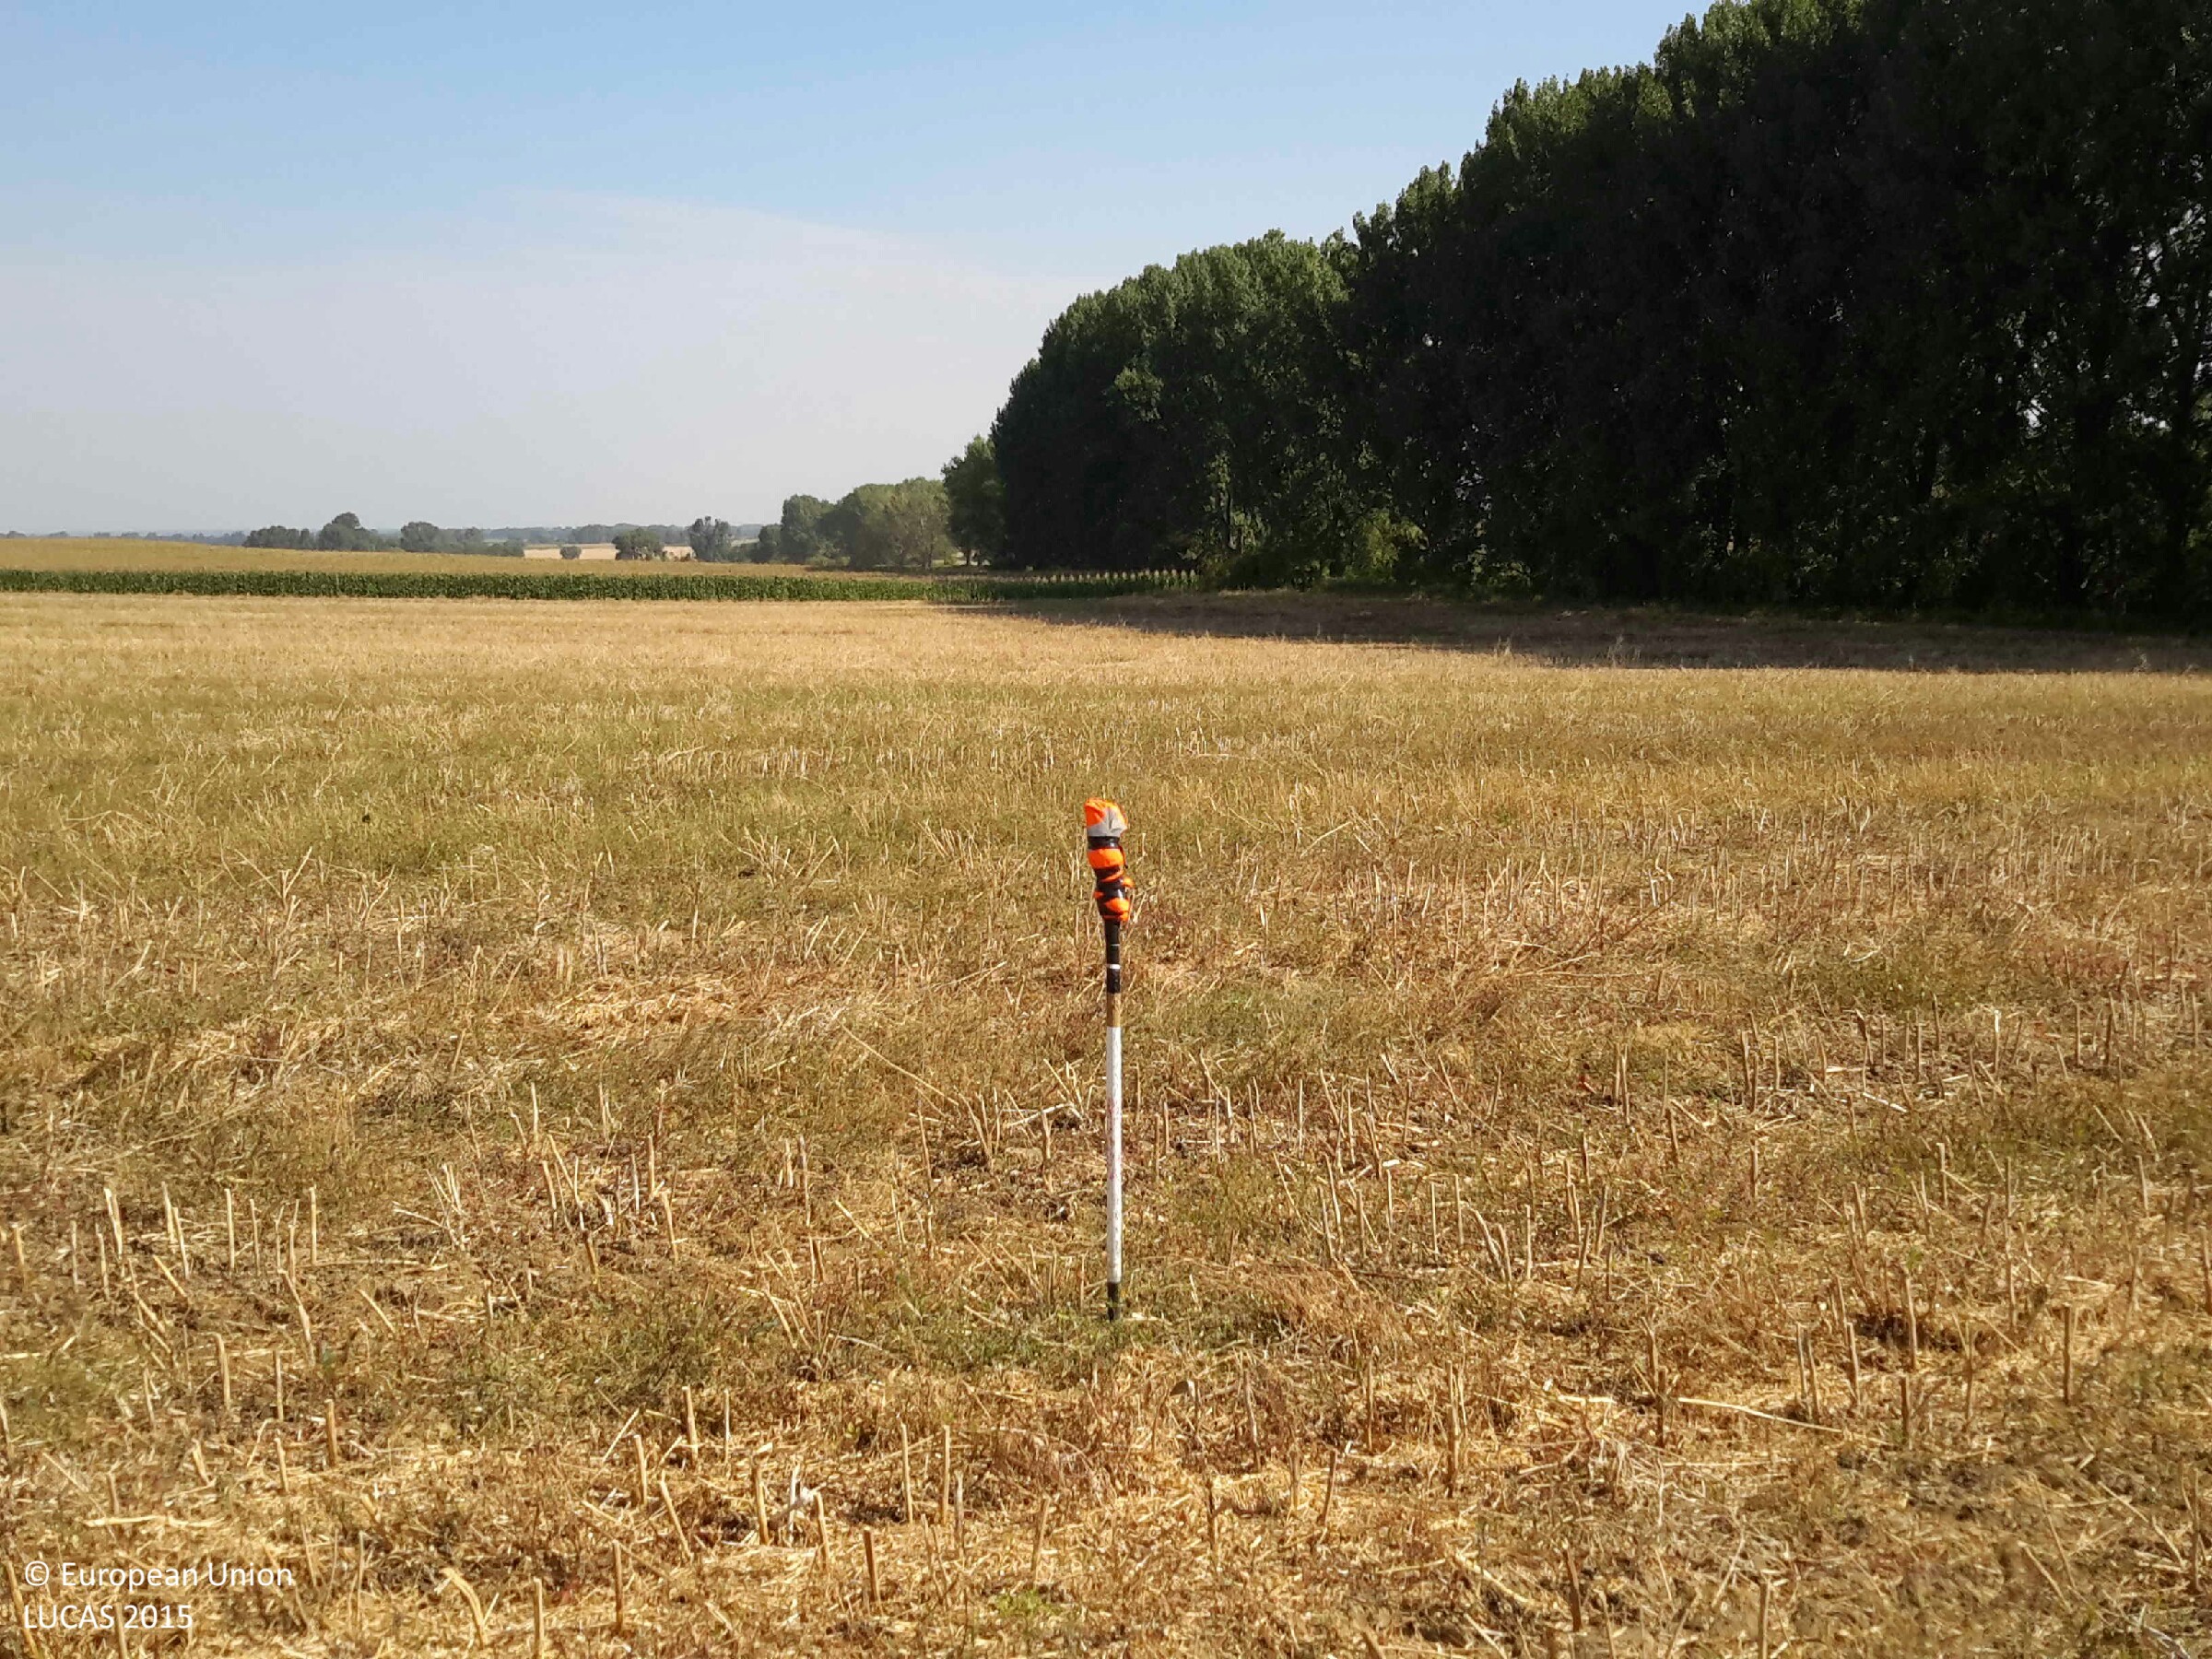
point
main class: Cropland
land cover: Rape and turnip rape
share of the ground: < 10 %
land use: Agriculture (excluding fallow land and kitchen gardens)
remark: Harvested field
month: July
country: HU
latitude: 47.4891
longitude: 17.8806
